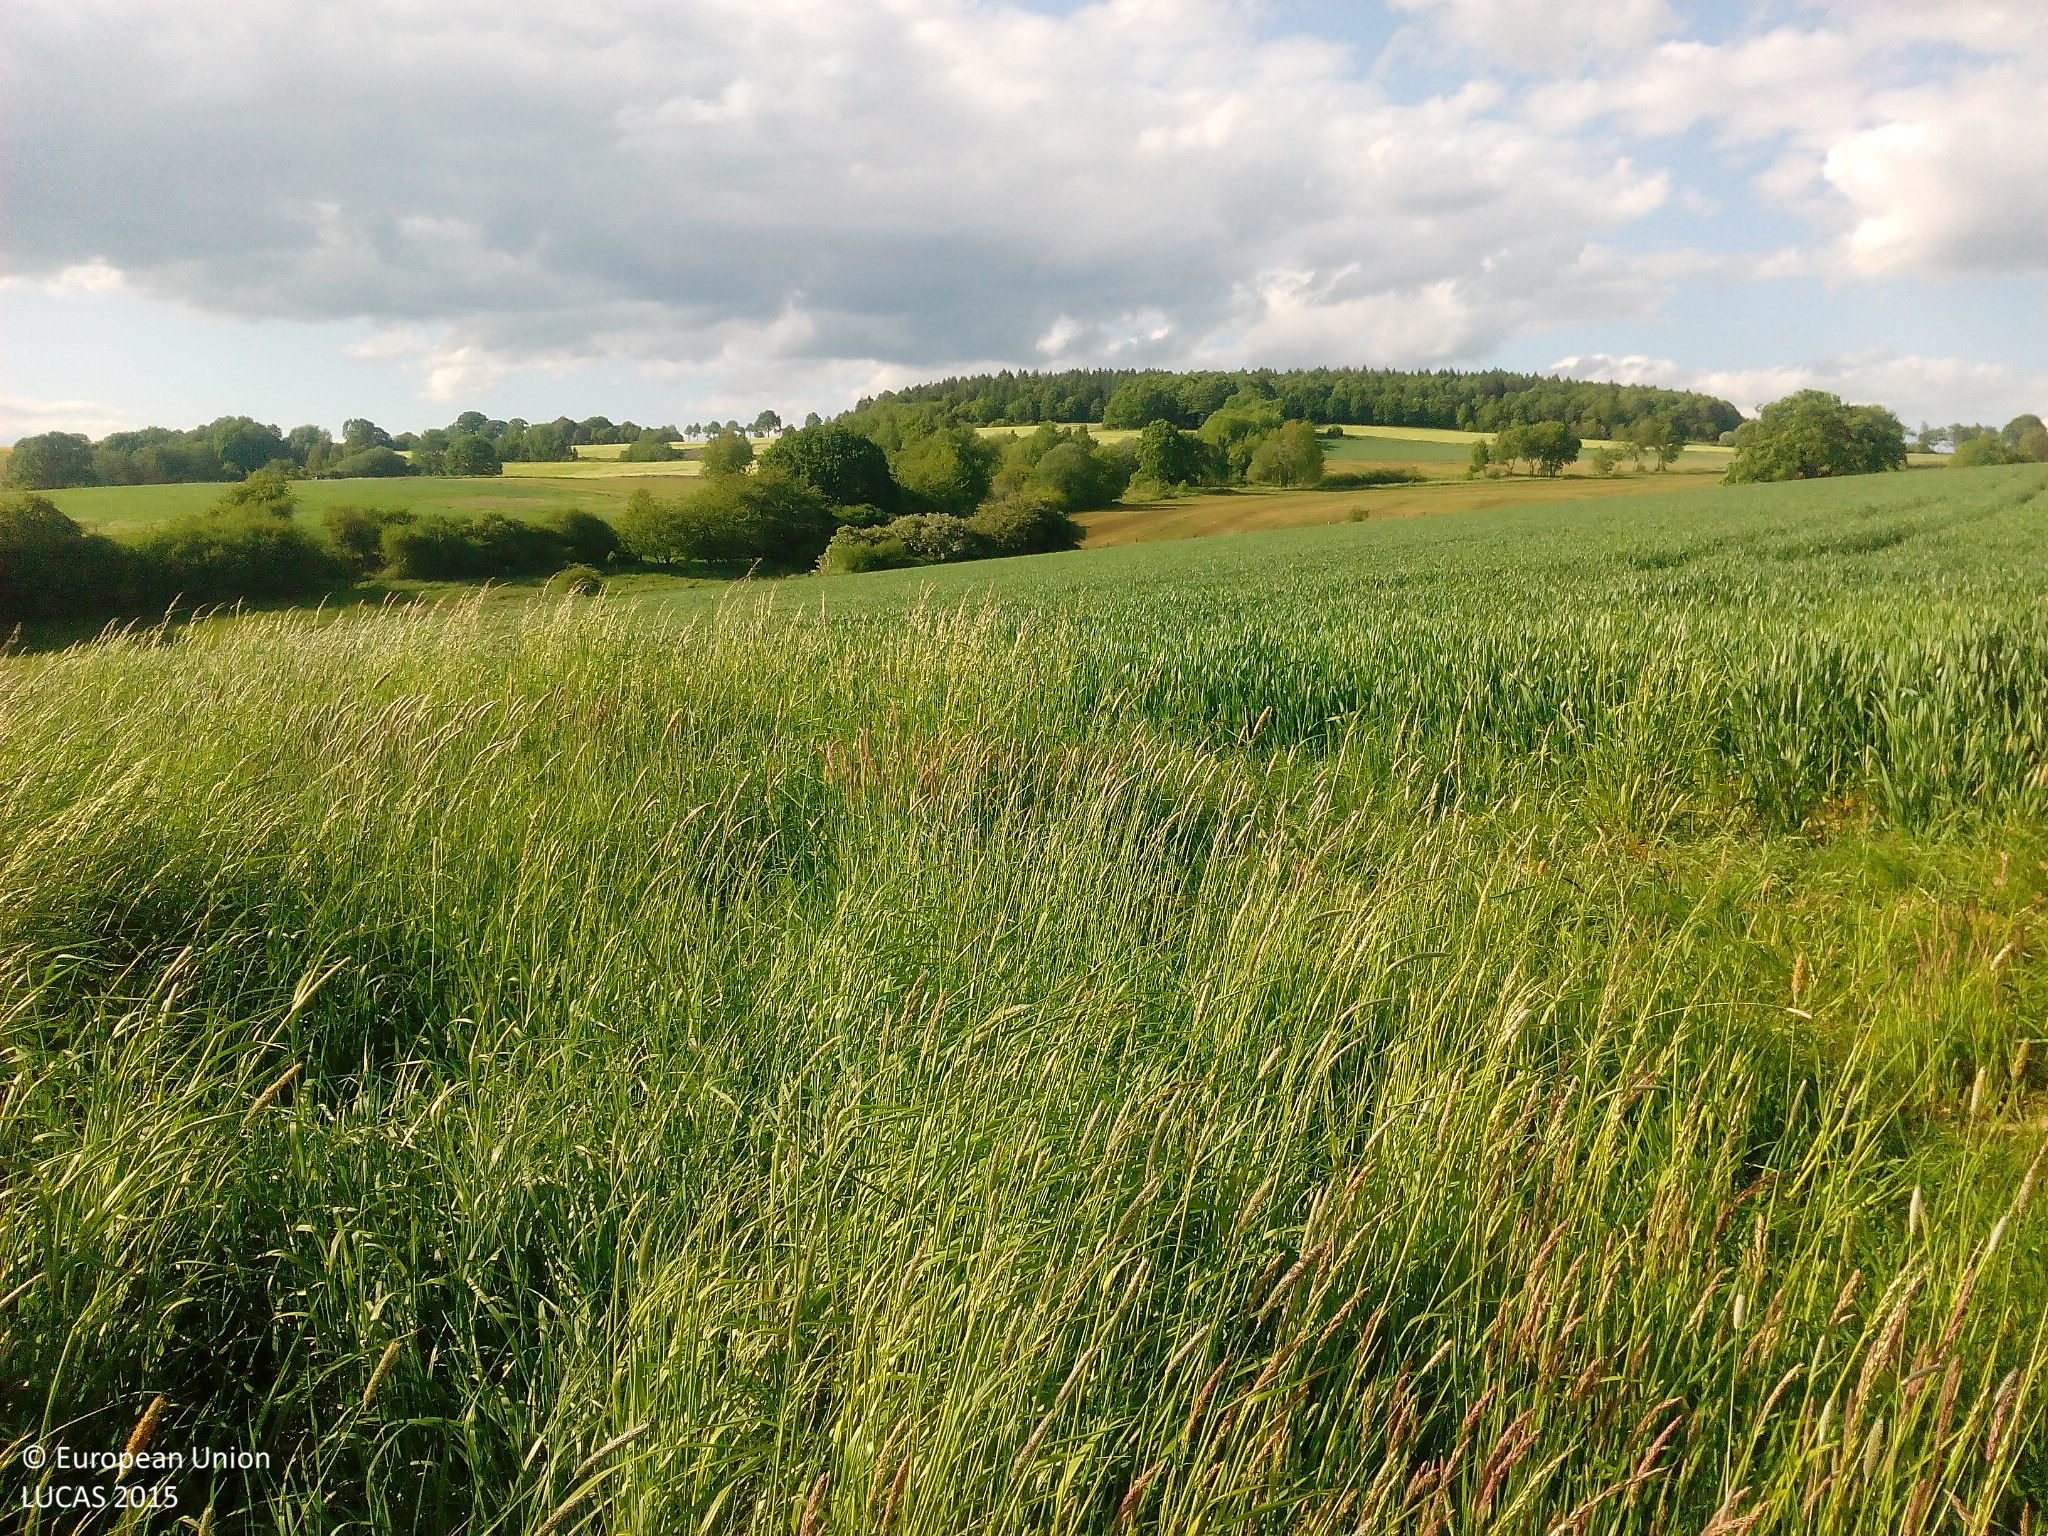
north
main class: Grassland
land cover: Grassland without tree/shrub cover
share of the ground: > 75 %
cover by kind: herbaceous plants 100 %
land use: Agriculture (excluding fallow land and kitchen gardens)
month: May
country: DE
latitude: 51.2984
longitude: 9.6416
